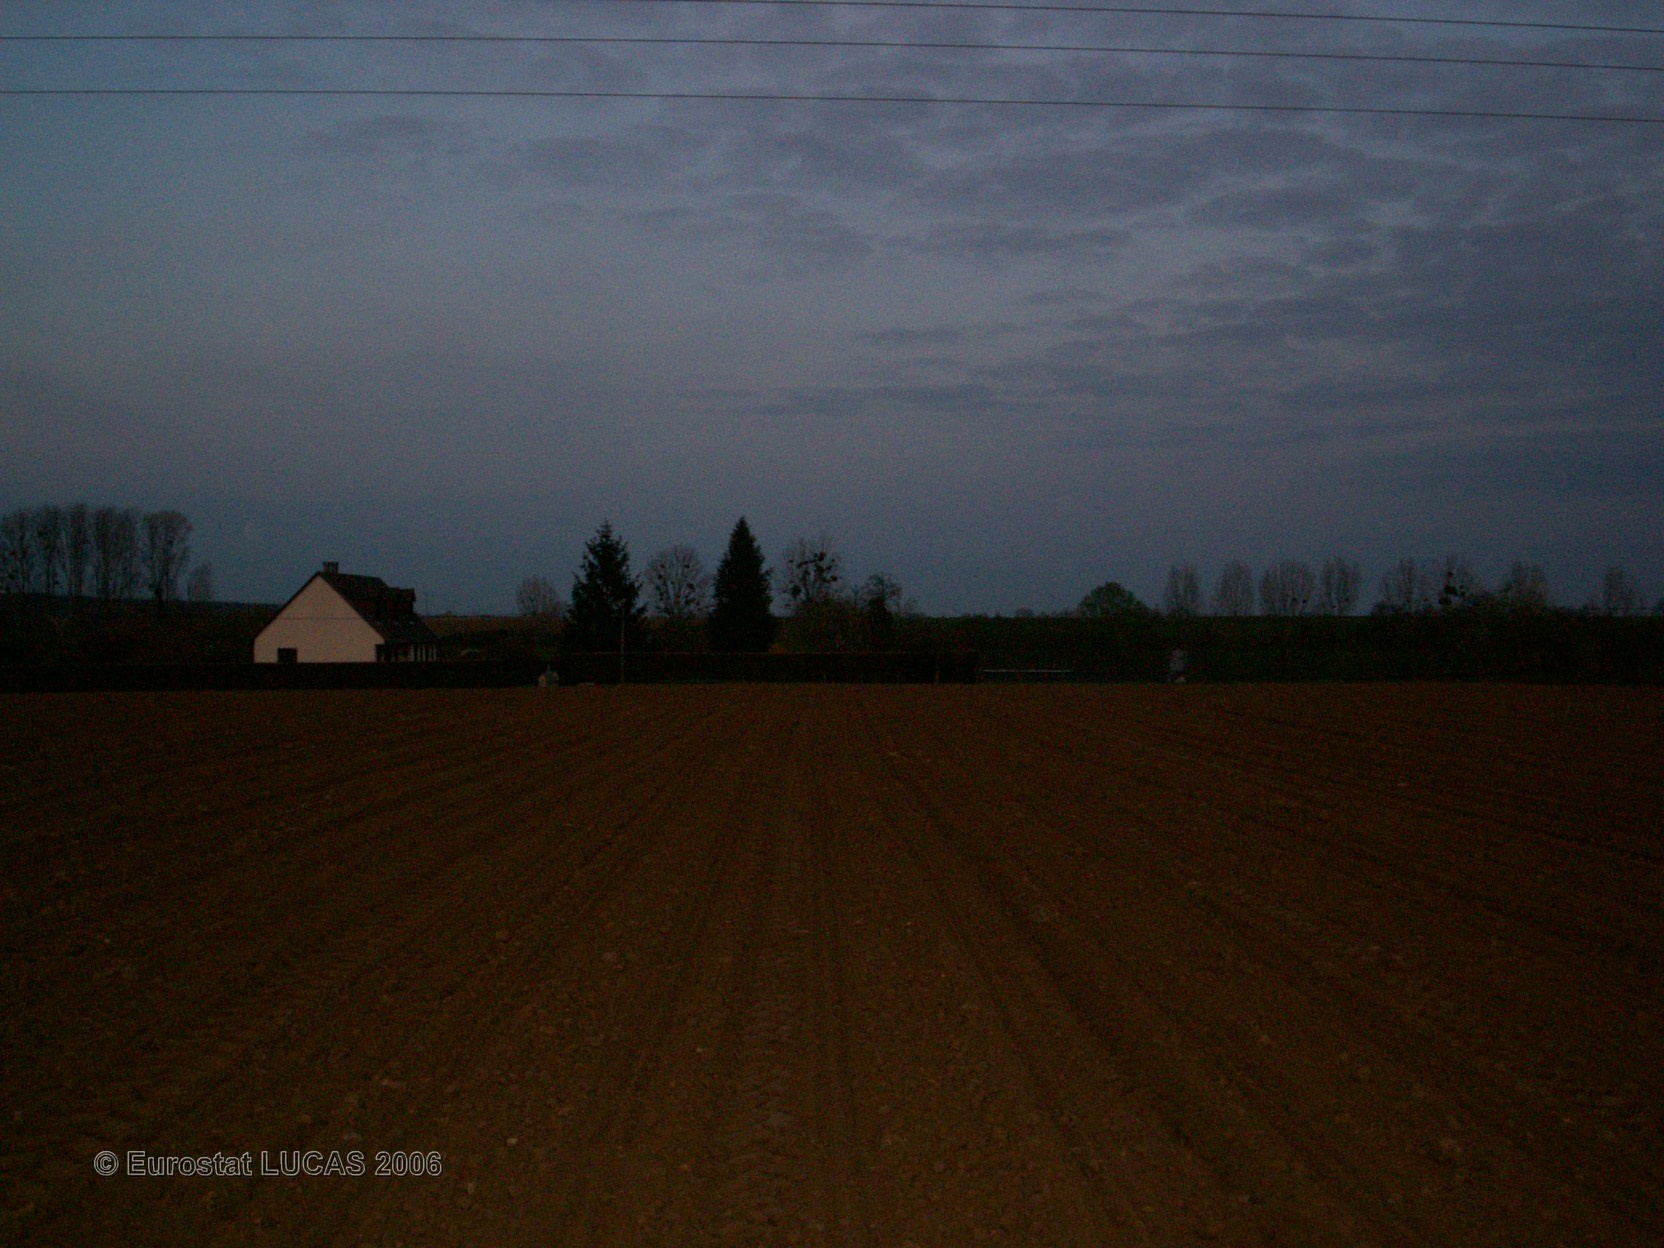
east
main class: Cropland
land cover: Maize
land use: Agriculture (excluding fallow land and kitchen gardens)
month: April
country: FR
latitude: 48.2863
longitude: 0.1204
